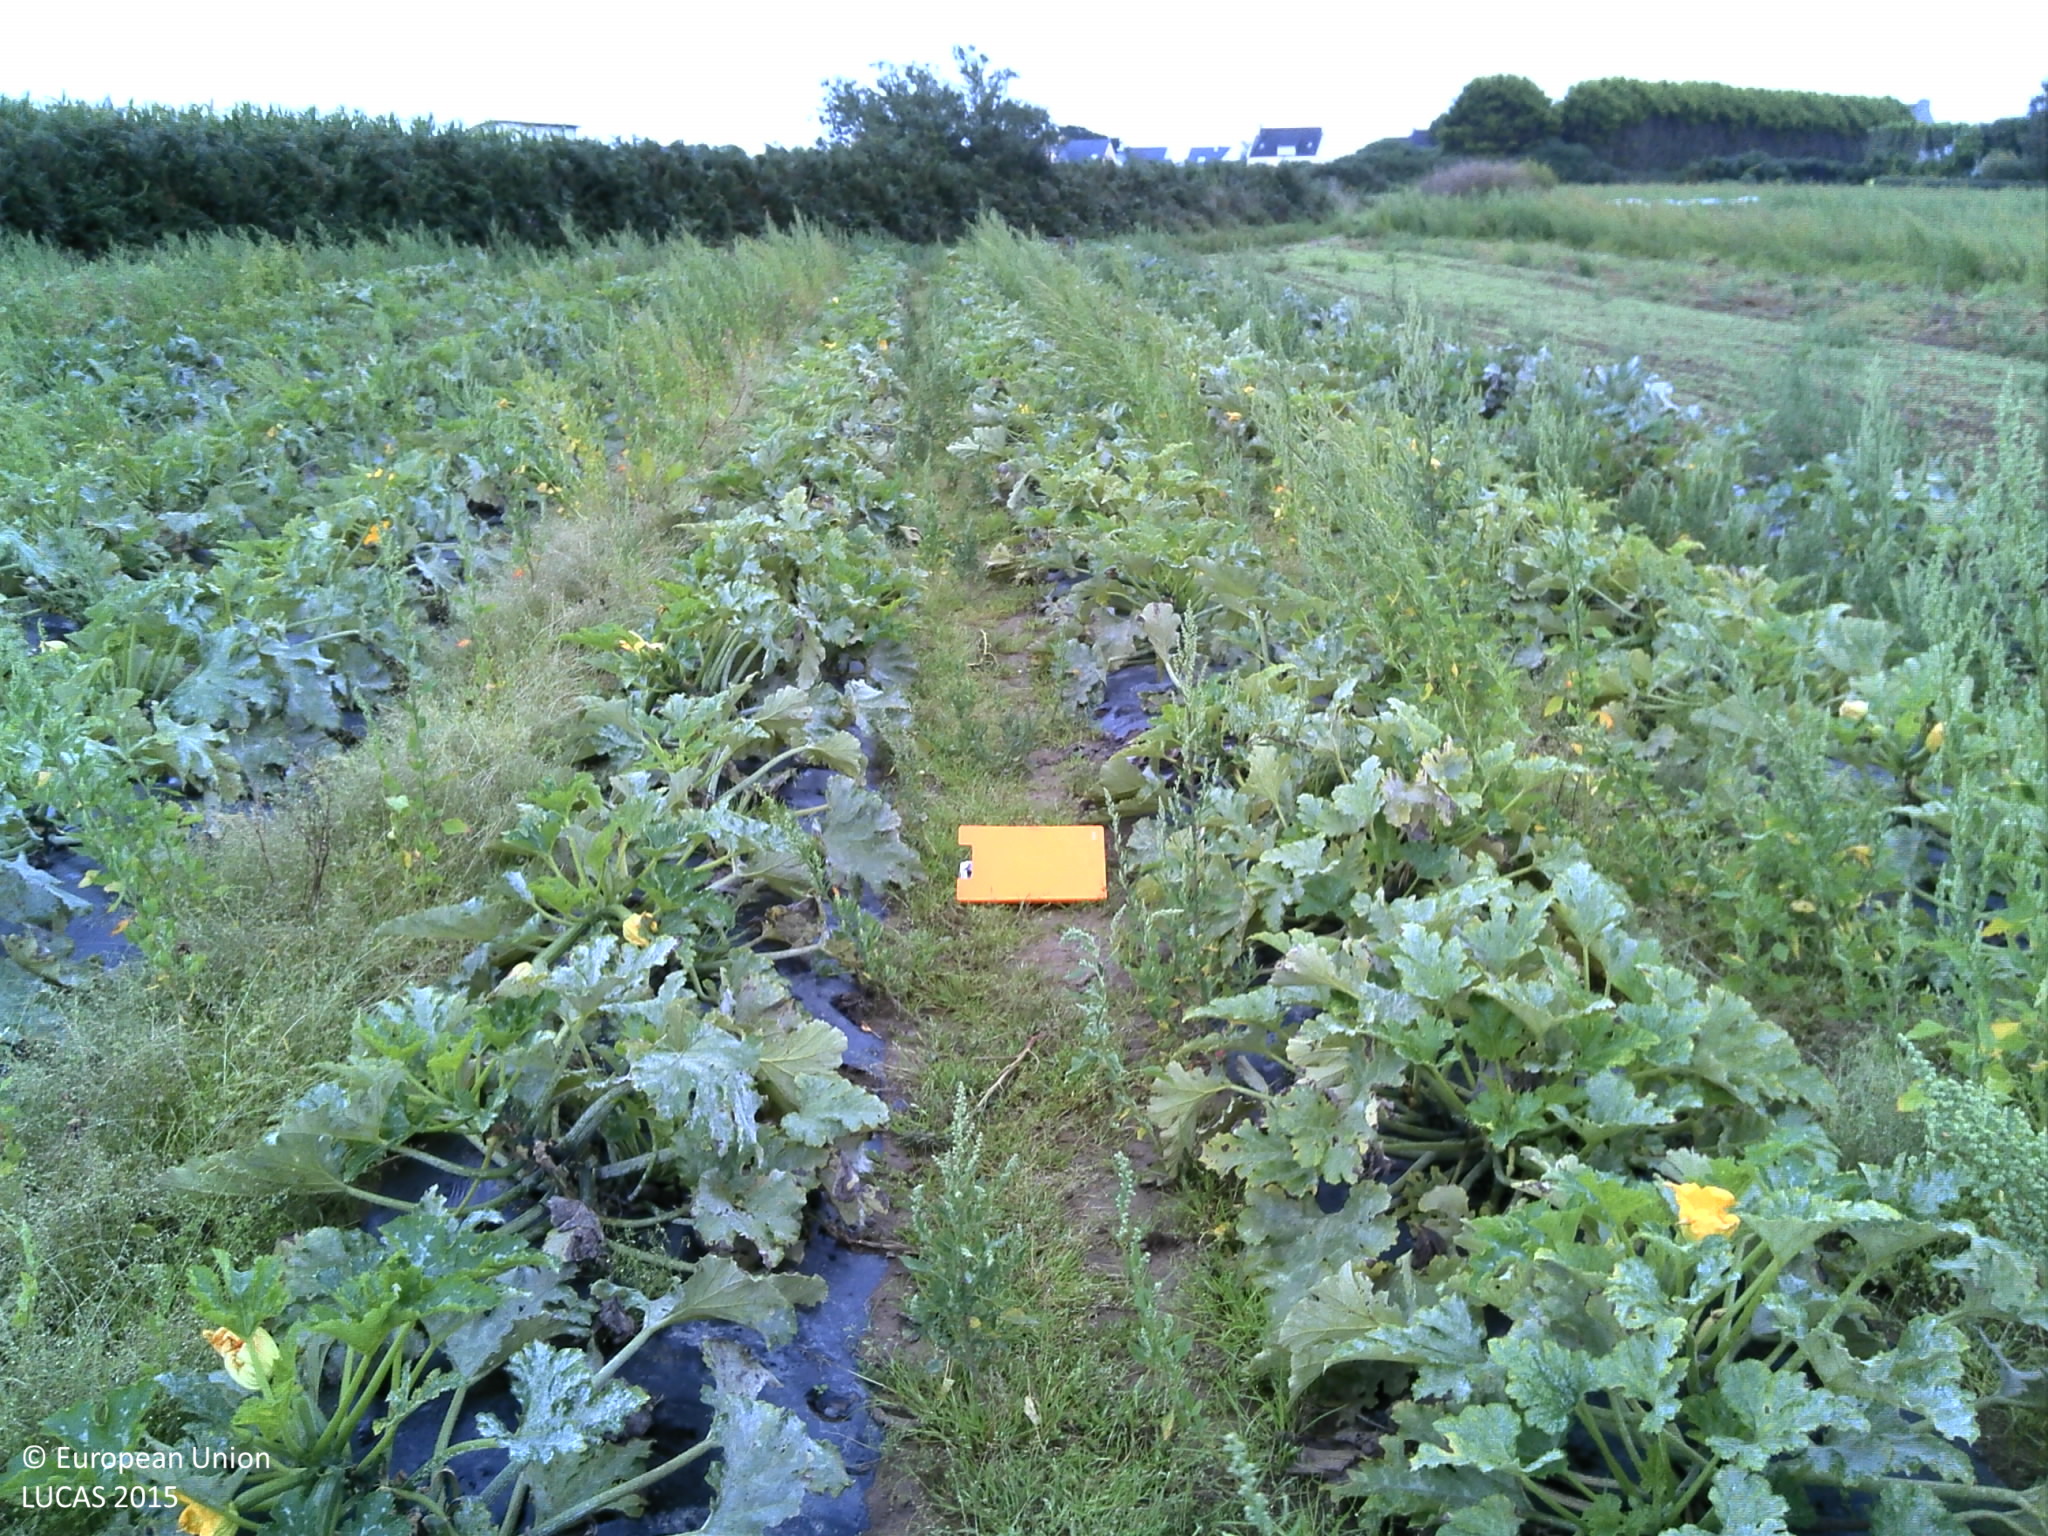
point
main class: Cropland
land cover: Other fresh vegetables
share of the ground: 50 - 75 %
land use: Agriculture (excluding fallow land and kitchen gardens)
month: August
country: FR
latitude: 48.6088
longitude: -4.5172
